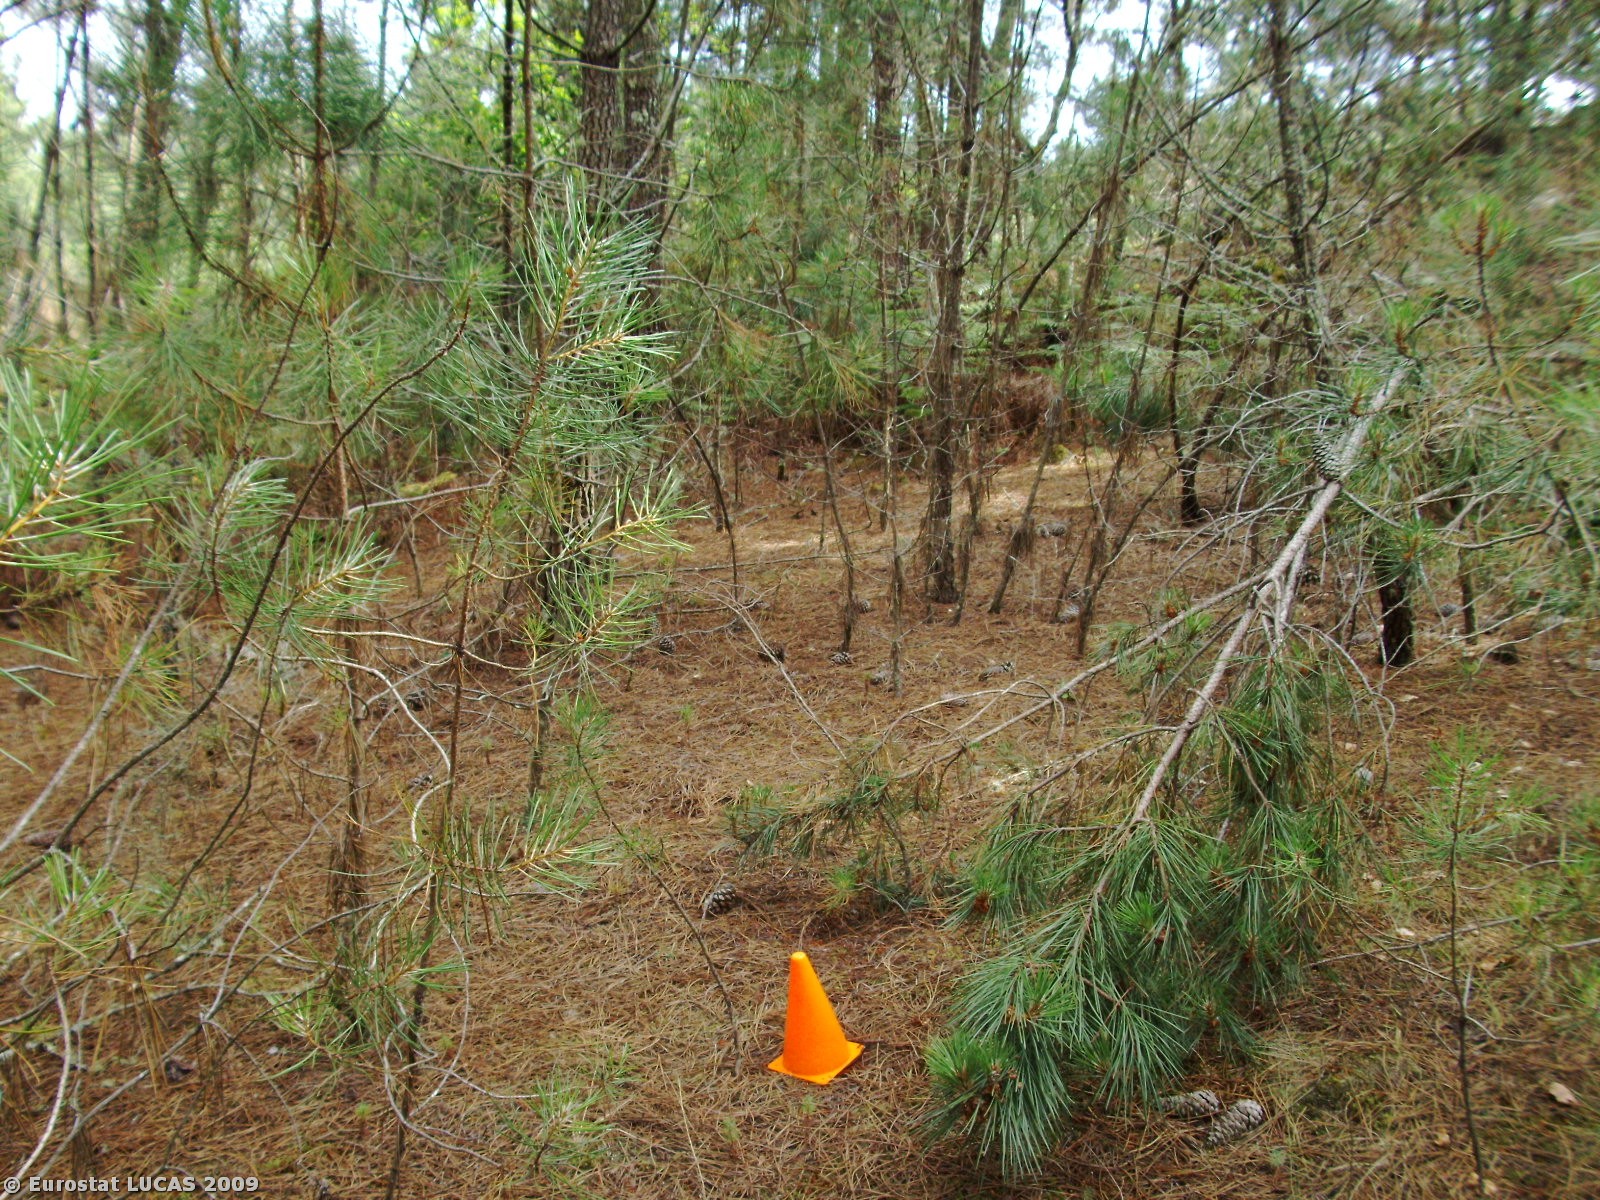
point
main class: Woodland
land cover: Coniferous woodland
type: coniferous forest of the mediterranean region
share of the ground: > 75 %
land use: Forestry
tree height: > 5 m
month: July
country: PT
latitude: 40.7294
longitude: -7.7027
